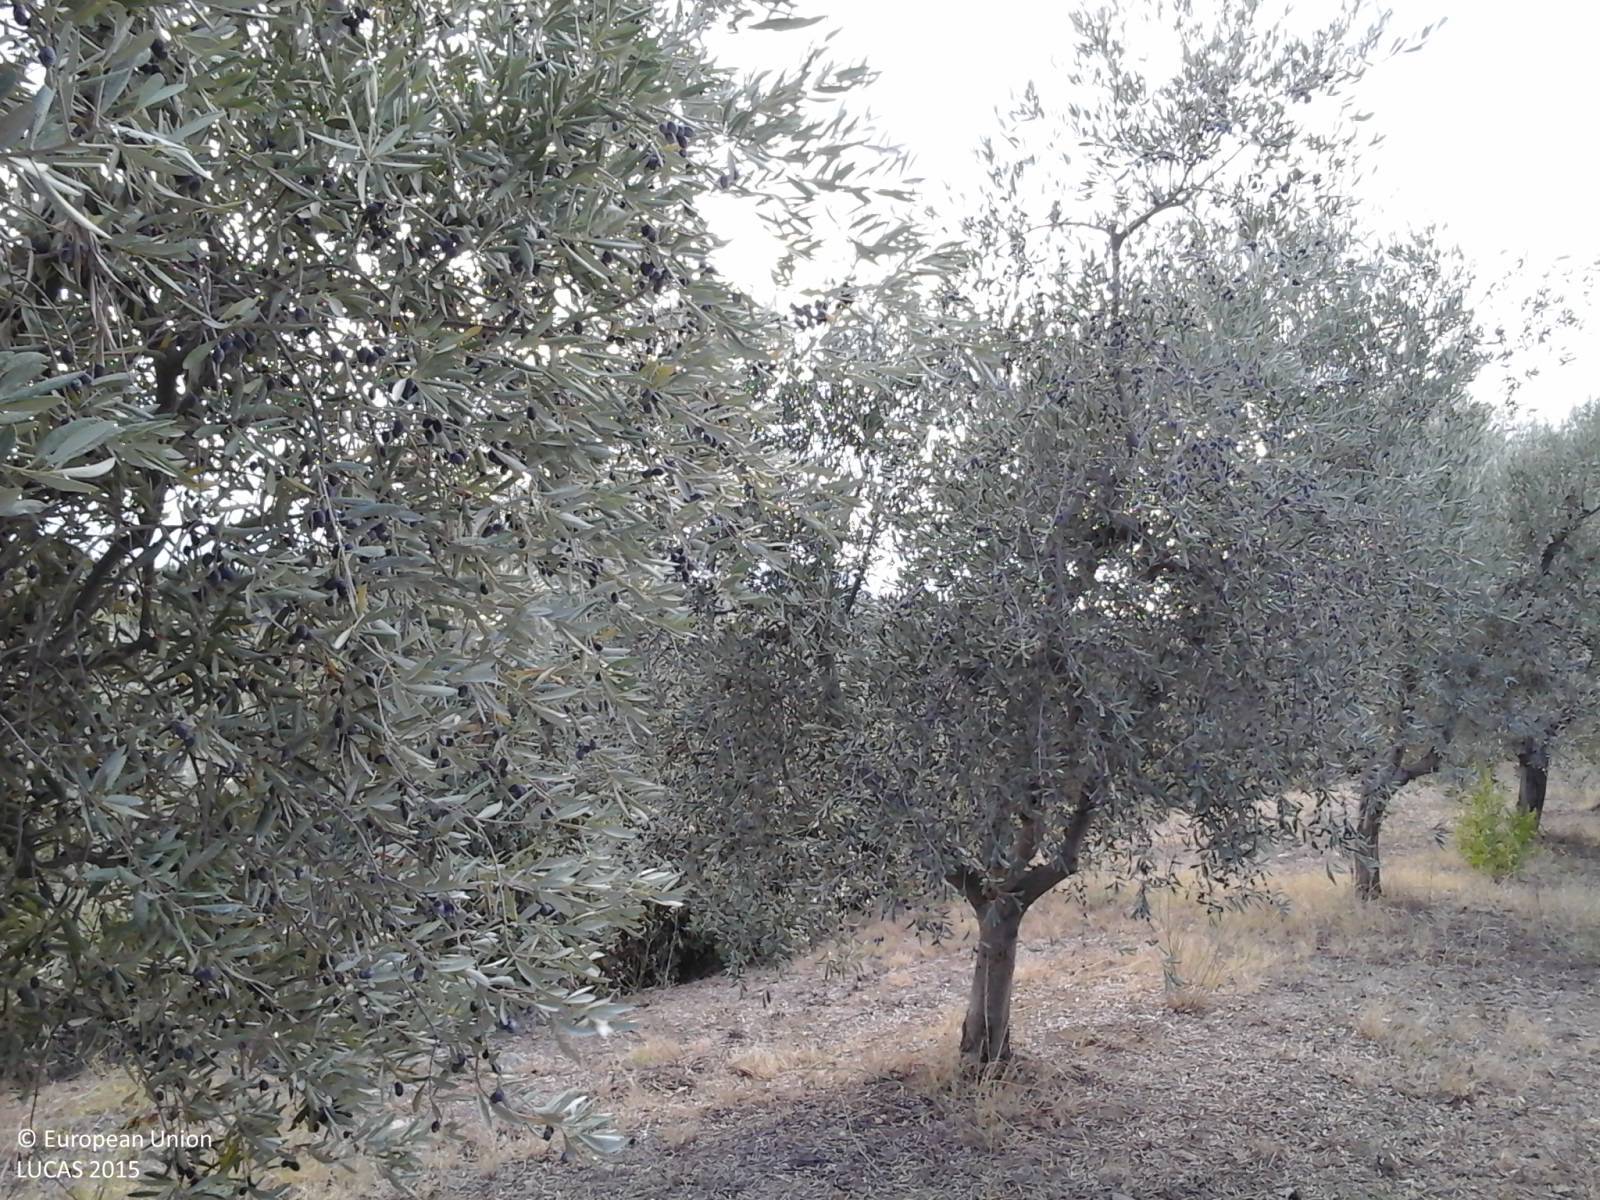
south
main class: Cropland
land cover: Olive groves
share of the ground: 25 - 50 %
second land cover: Grassland without tree/shrub cover
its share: 50 - 75 %
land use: Agriculture (excluding fallow land and kitchen gardens)
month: September
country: IT
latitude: 43.0677
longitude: 10.5754
